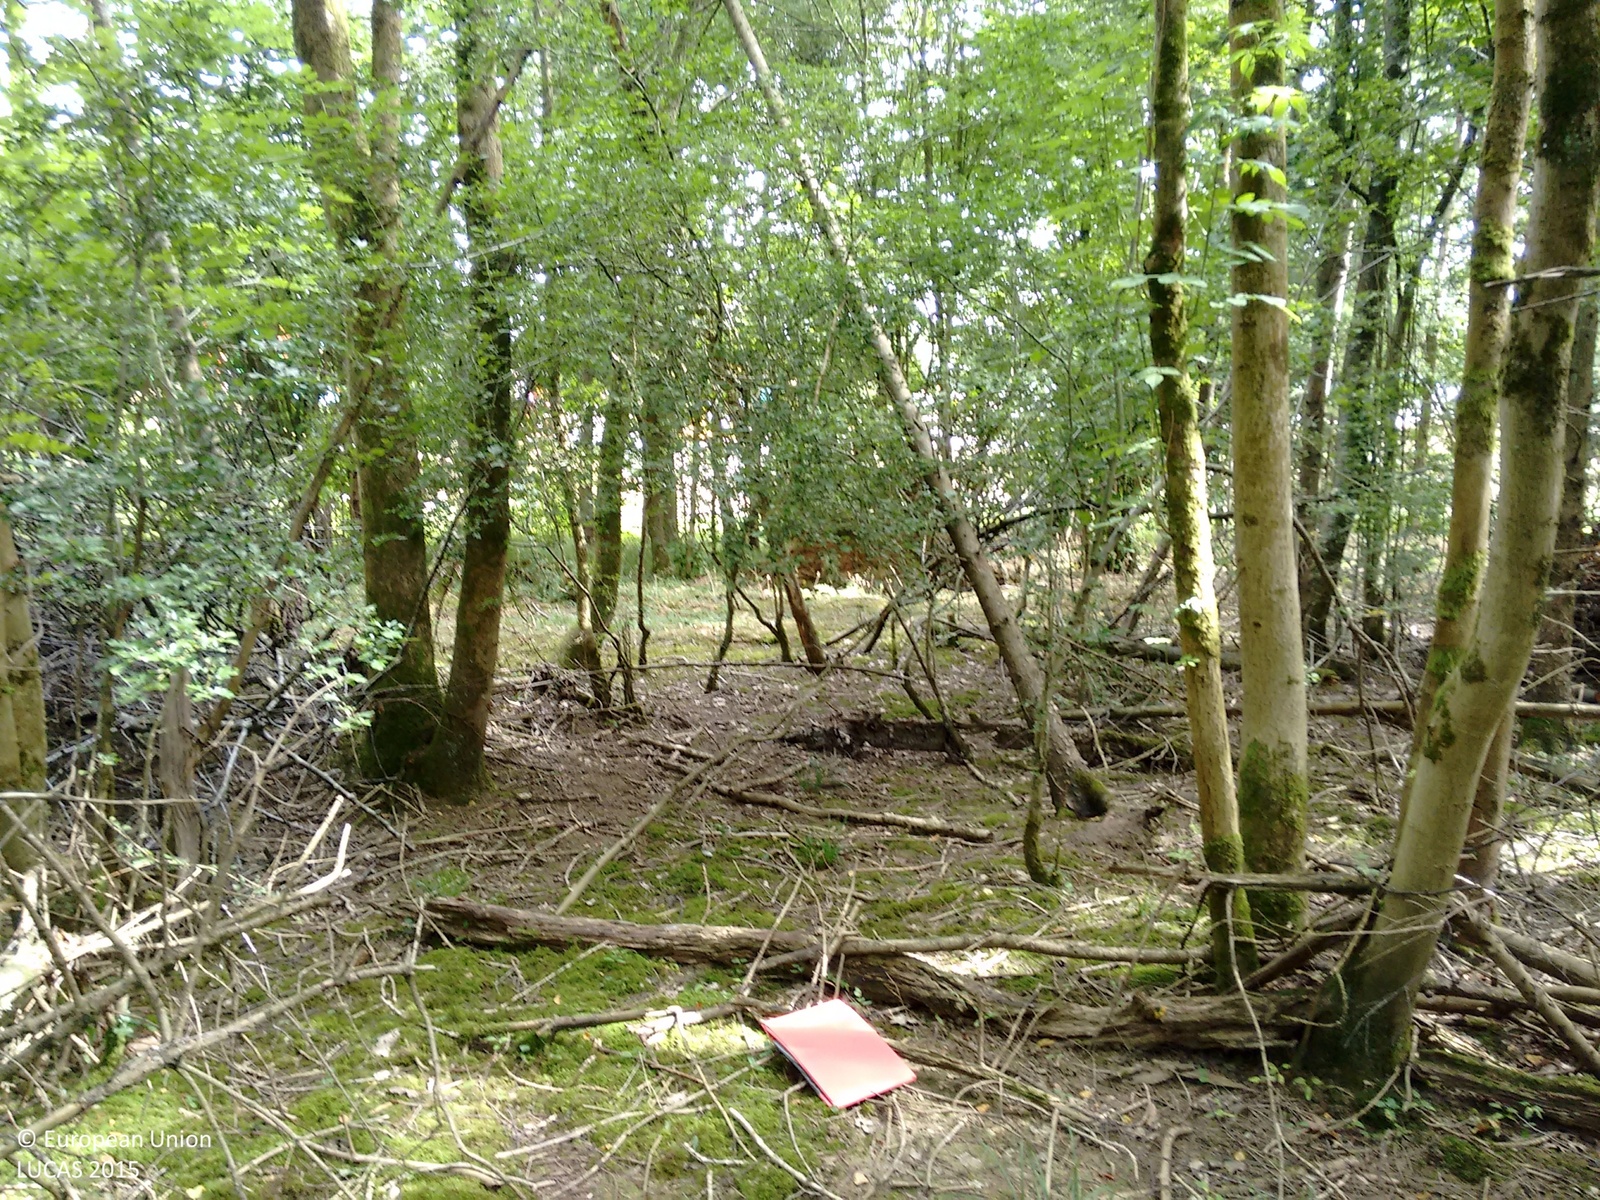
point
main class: Woodland
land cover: Spruce dominated mixed woodland
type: exotic forest
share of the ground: > 75 %
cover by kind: broadleaved forest trees 50 %, coniferous forest trees 40 %, shrubs 10 %
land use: Forestry
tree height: > 5 m
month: August
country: GB
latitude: 51.2033
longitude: -0.2981
